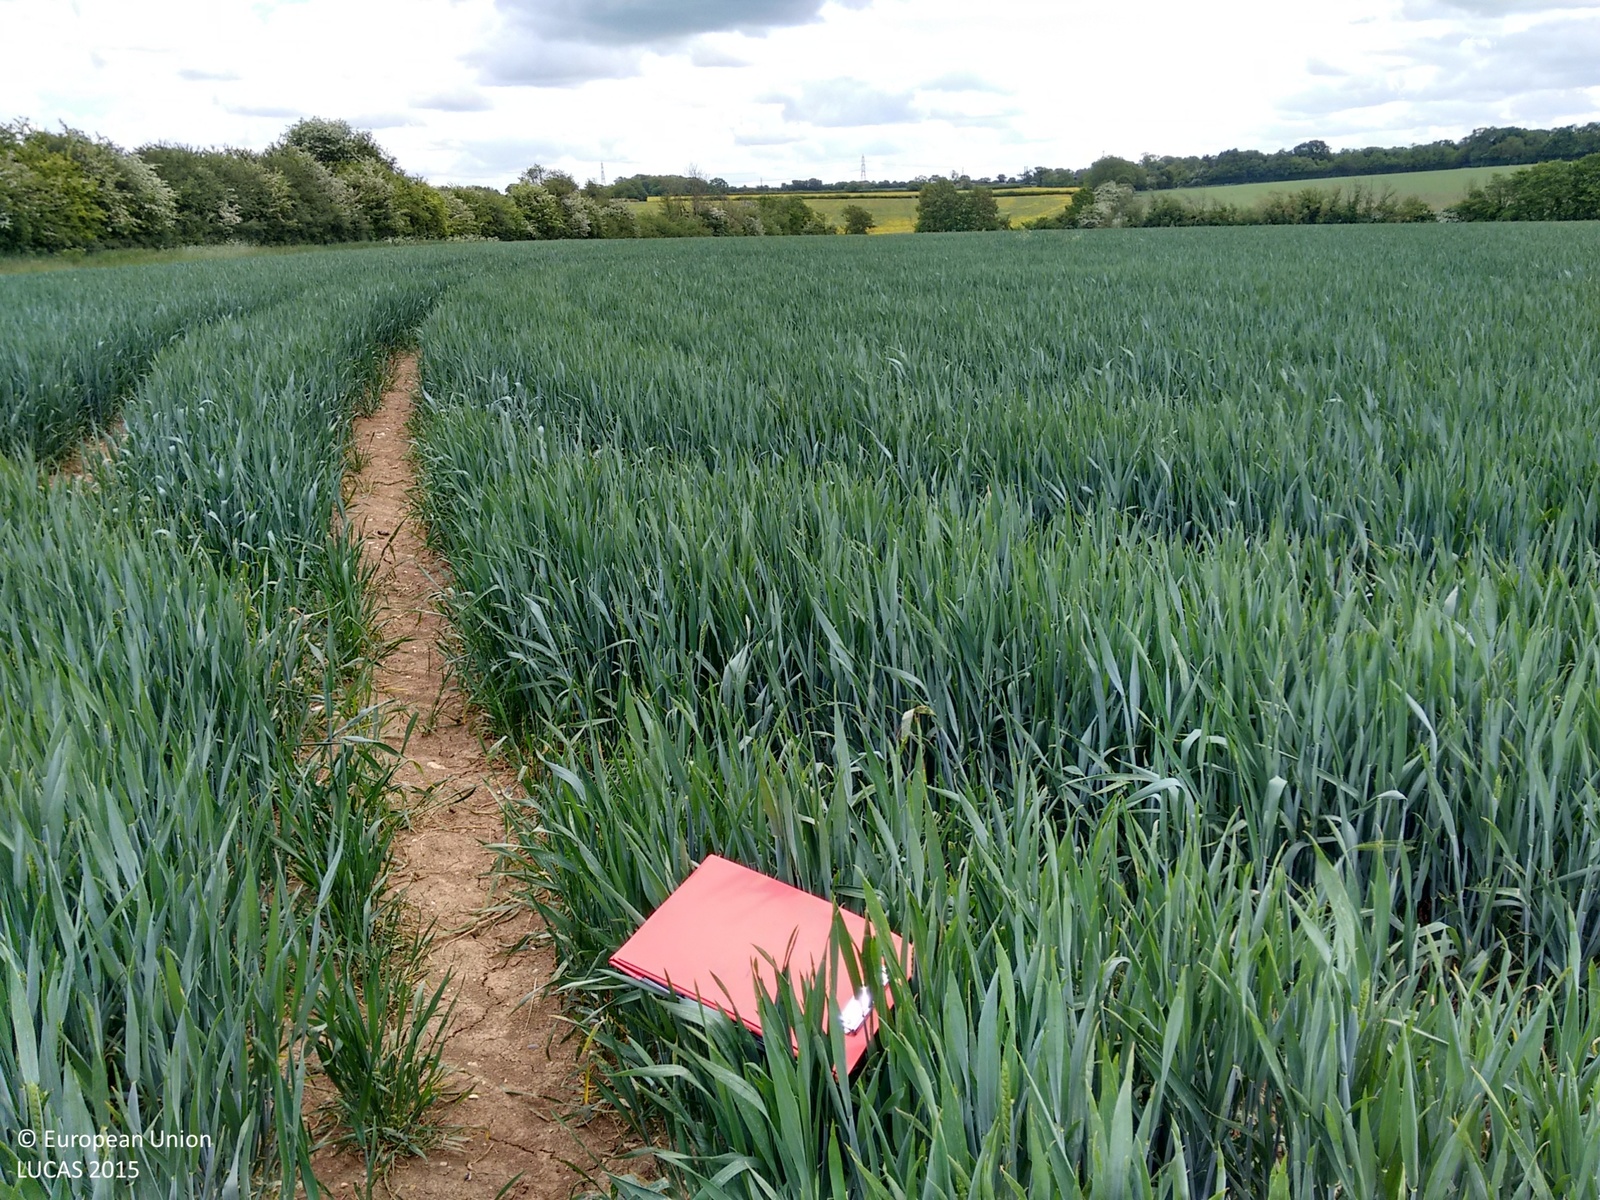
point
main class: Cropland
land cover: Common wheat
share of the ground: > 75 %
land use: Agriculture (excluding fallow land and kitchen gardens)
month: May
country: GB
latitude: 51.9260
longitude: 0.0943
